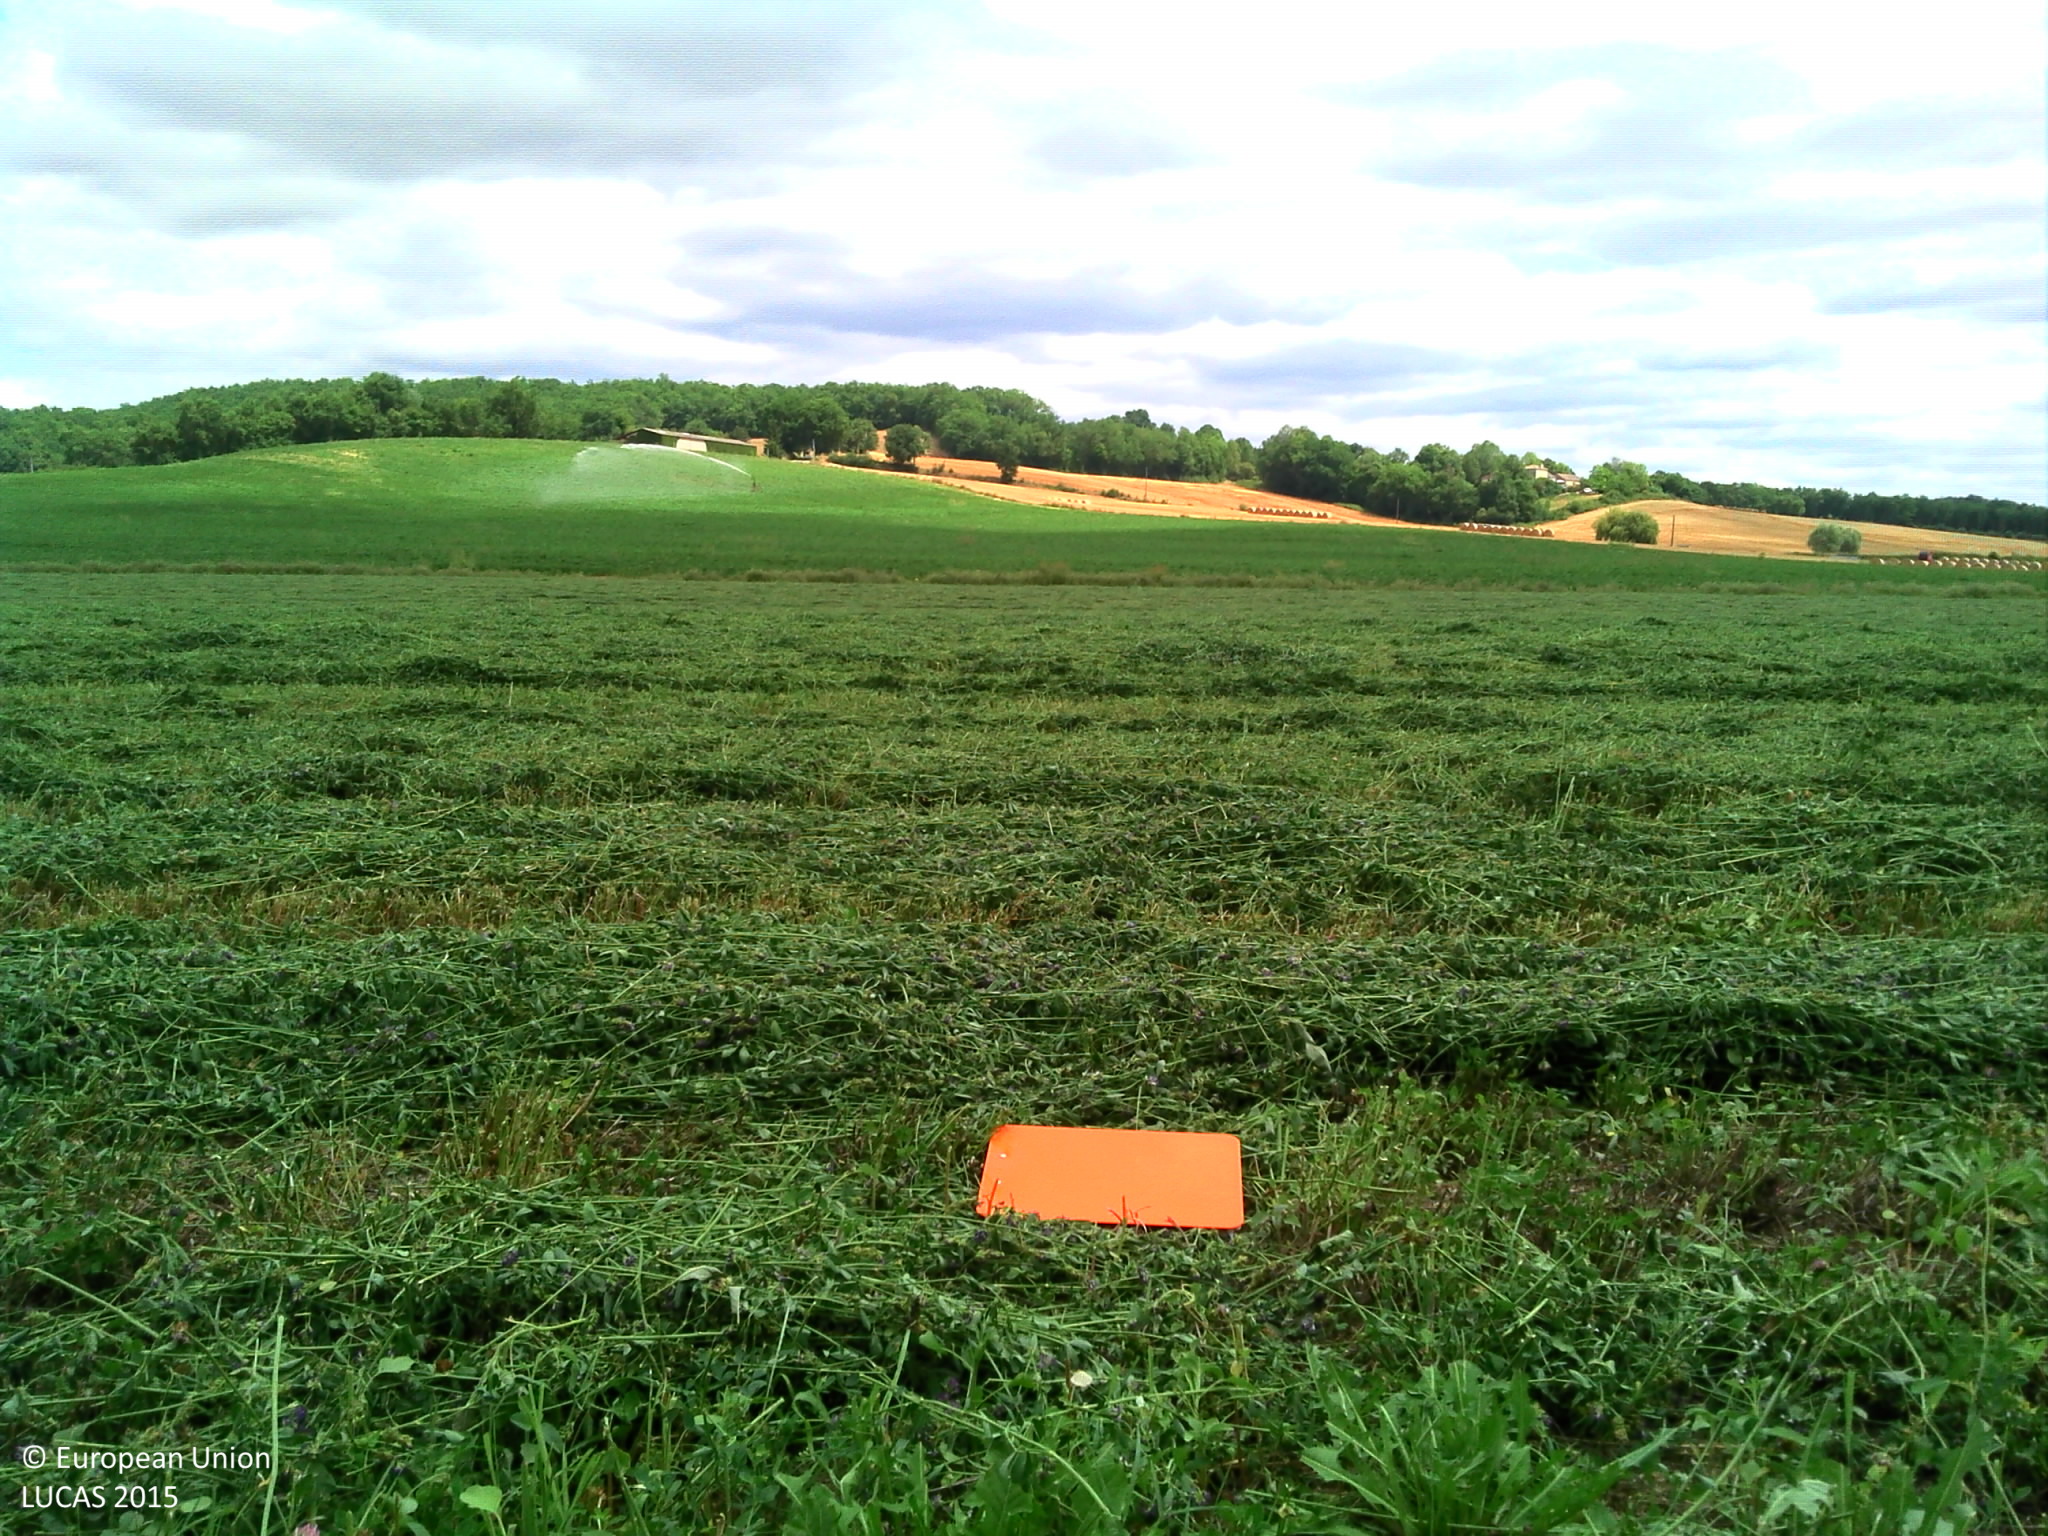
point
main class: Cropland
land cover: Lucerne
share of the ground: > 75 %
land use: Agriculture (excluding fallow land and kitchen gardens)
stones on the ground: < 10 %
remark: Harvested field
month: July
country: FR
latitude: 44.6644
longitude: 0.7734
